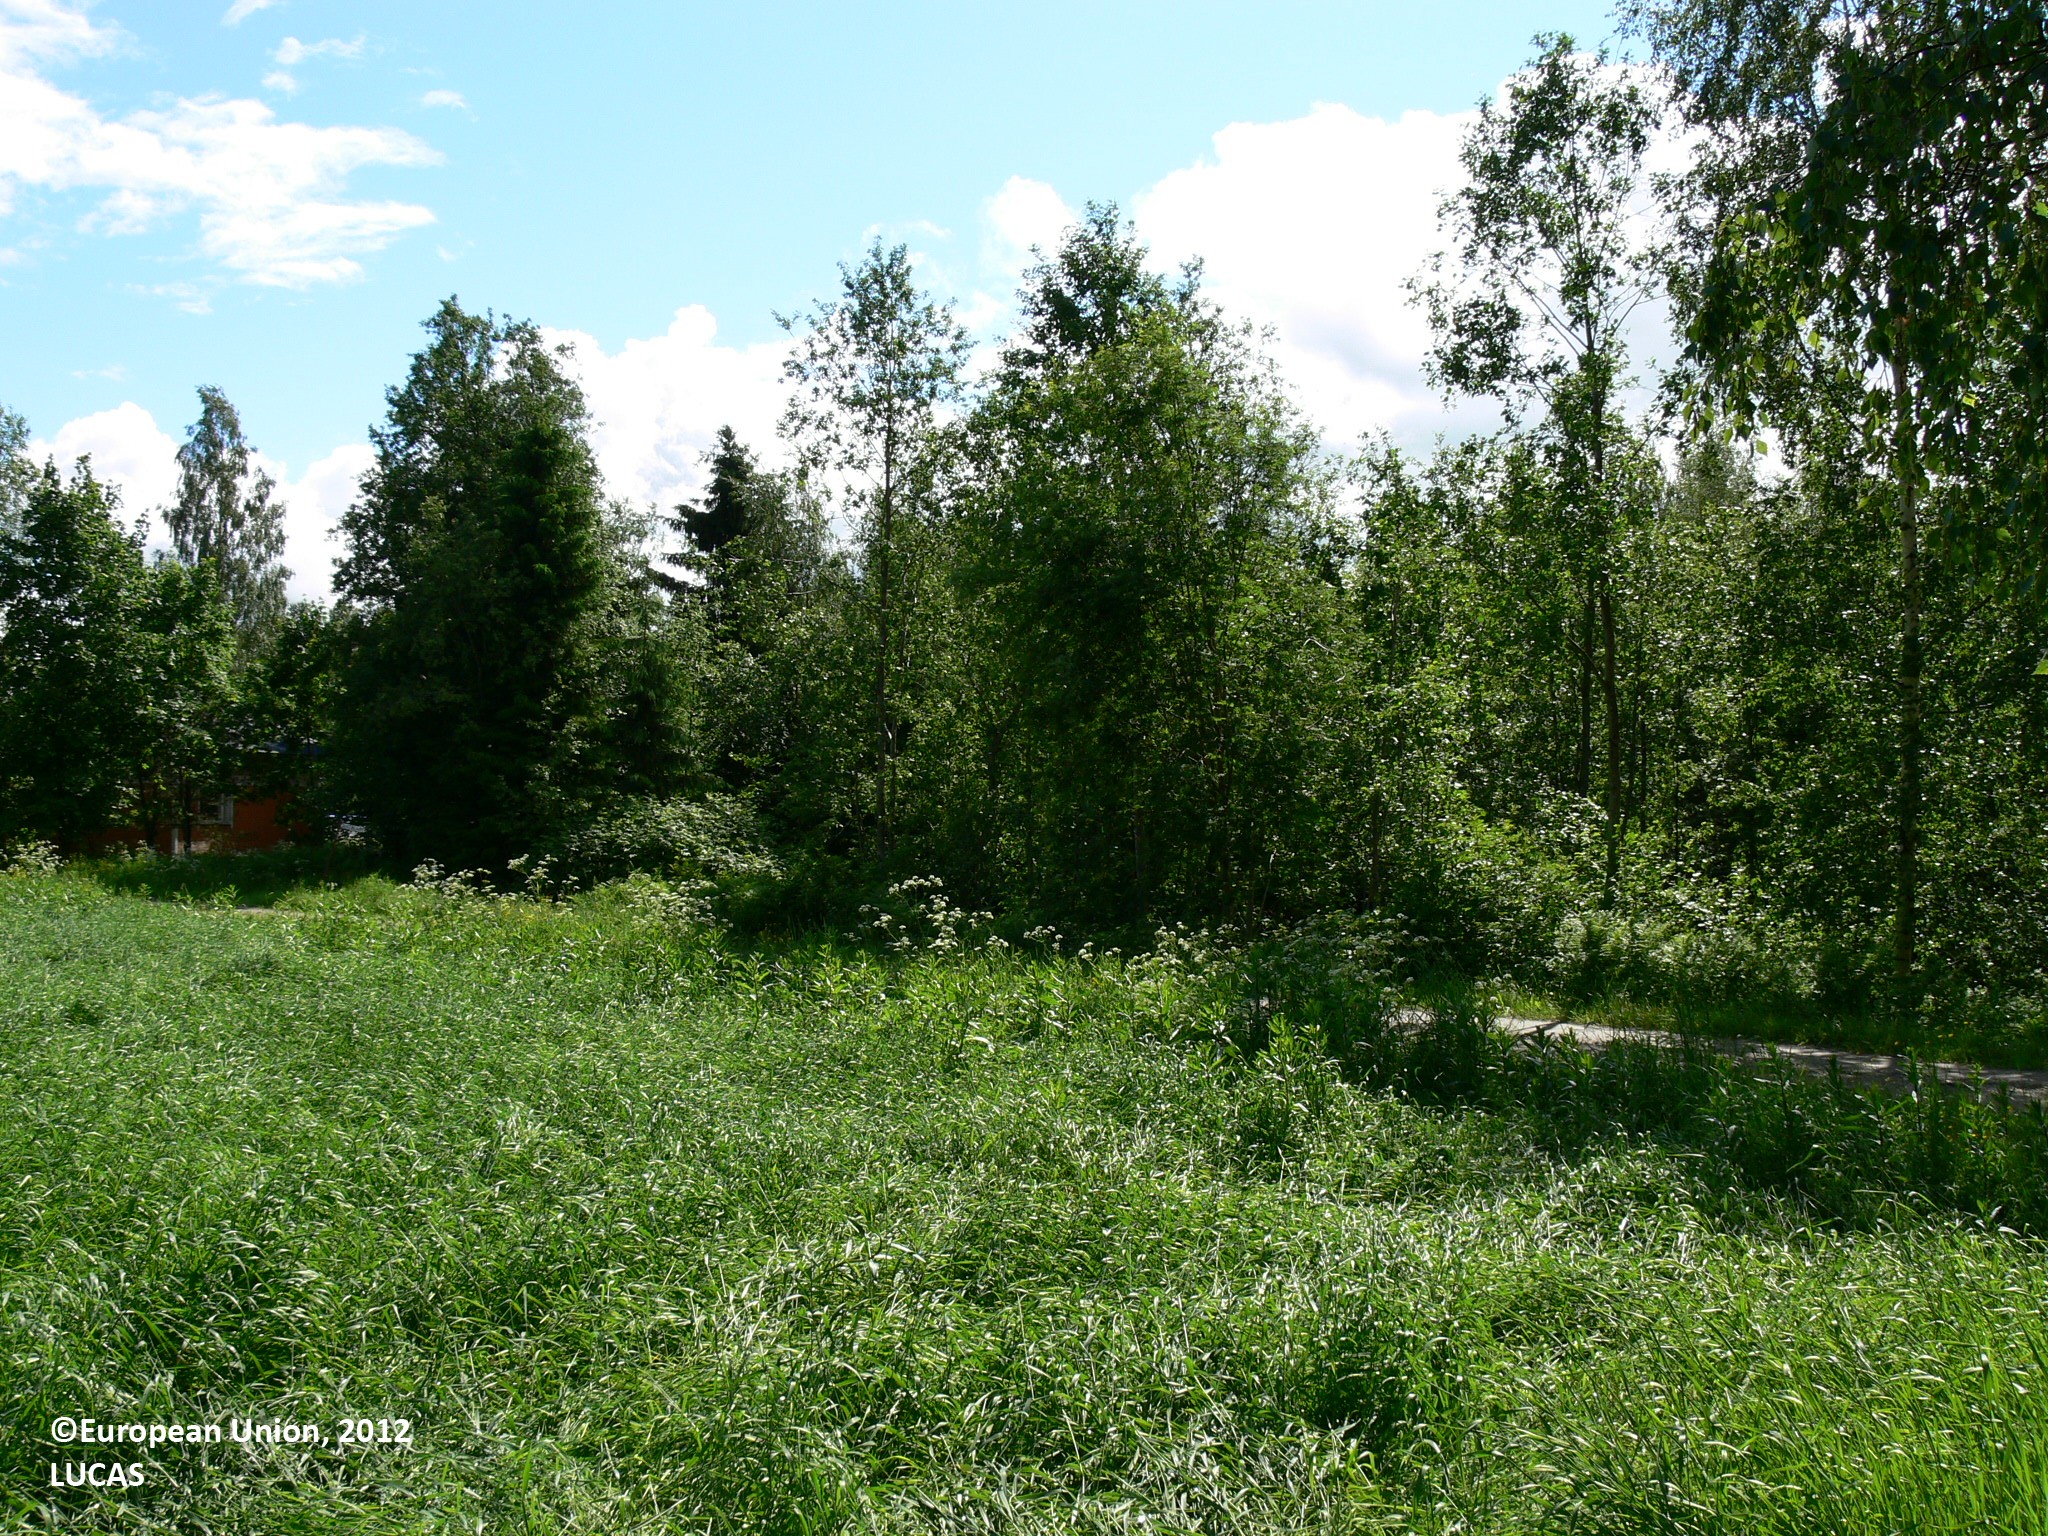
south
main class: Cropland
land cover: Temporary grasslands
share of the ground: > 75 %
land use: Agriculture (excluding fallow land and kitchen gardens)
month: June
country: FI
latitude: 62.6567
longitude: 29.2550
